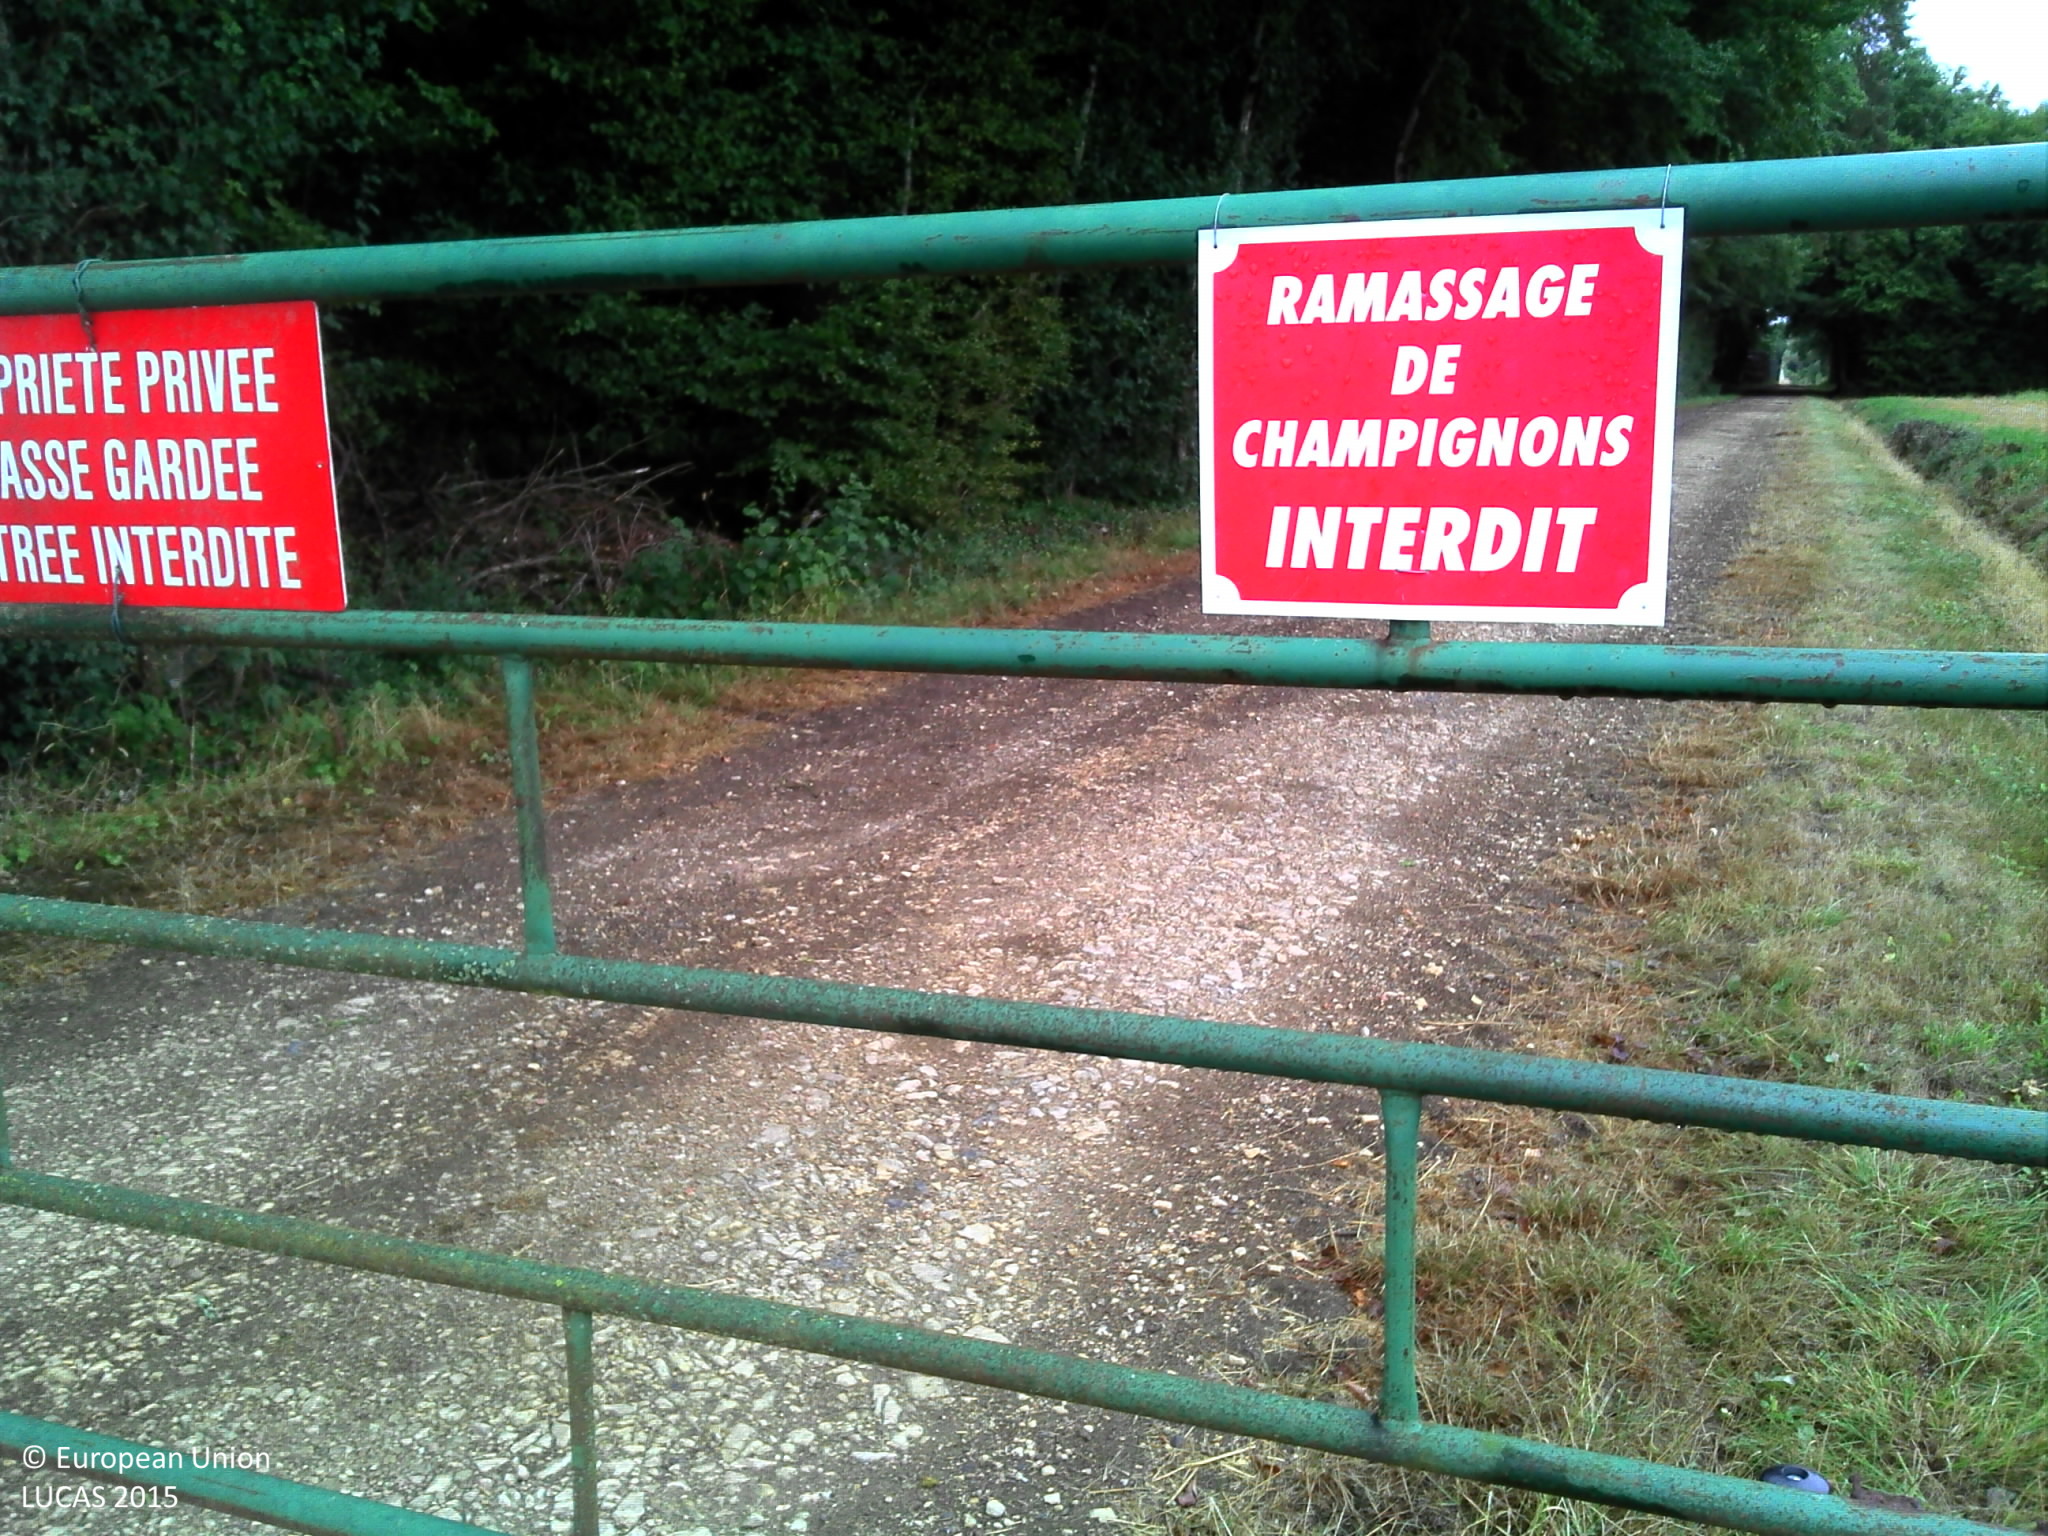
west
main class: Woodland
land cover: Broadleaved woodland
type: mesophytic deciduous forest
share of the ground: > 75 %
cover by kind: broadleaved forest trees 100 %
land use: Forestry
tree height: > 5 m
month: July
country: FR
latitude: 46.8573
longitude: 2.1354
